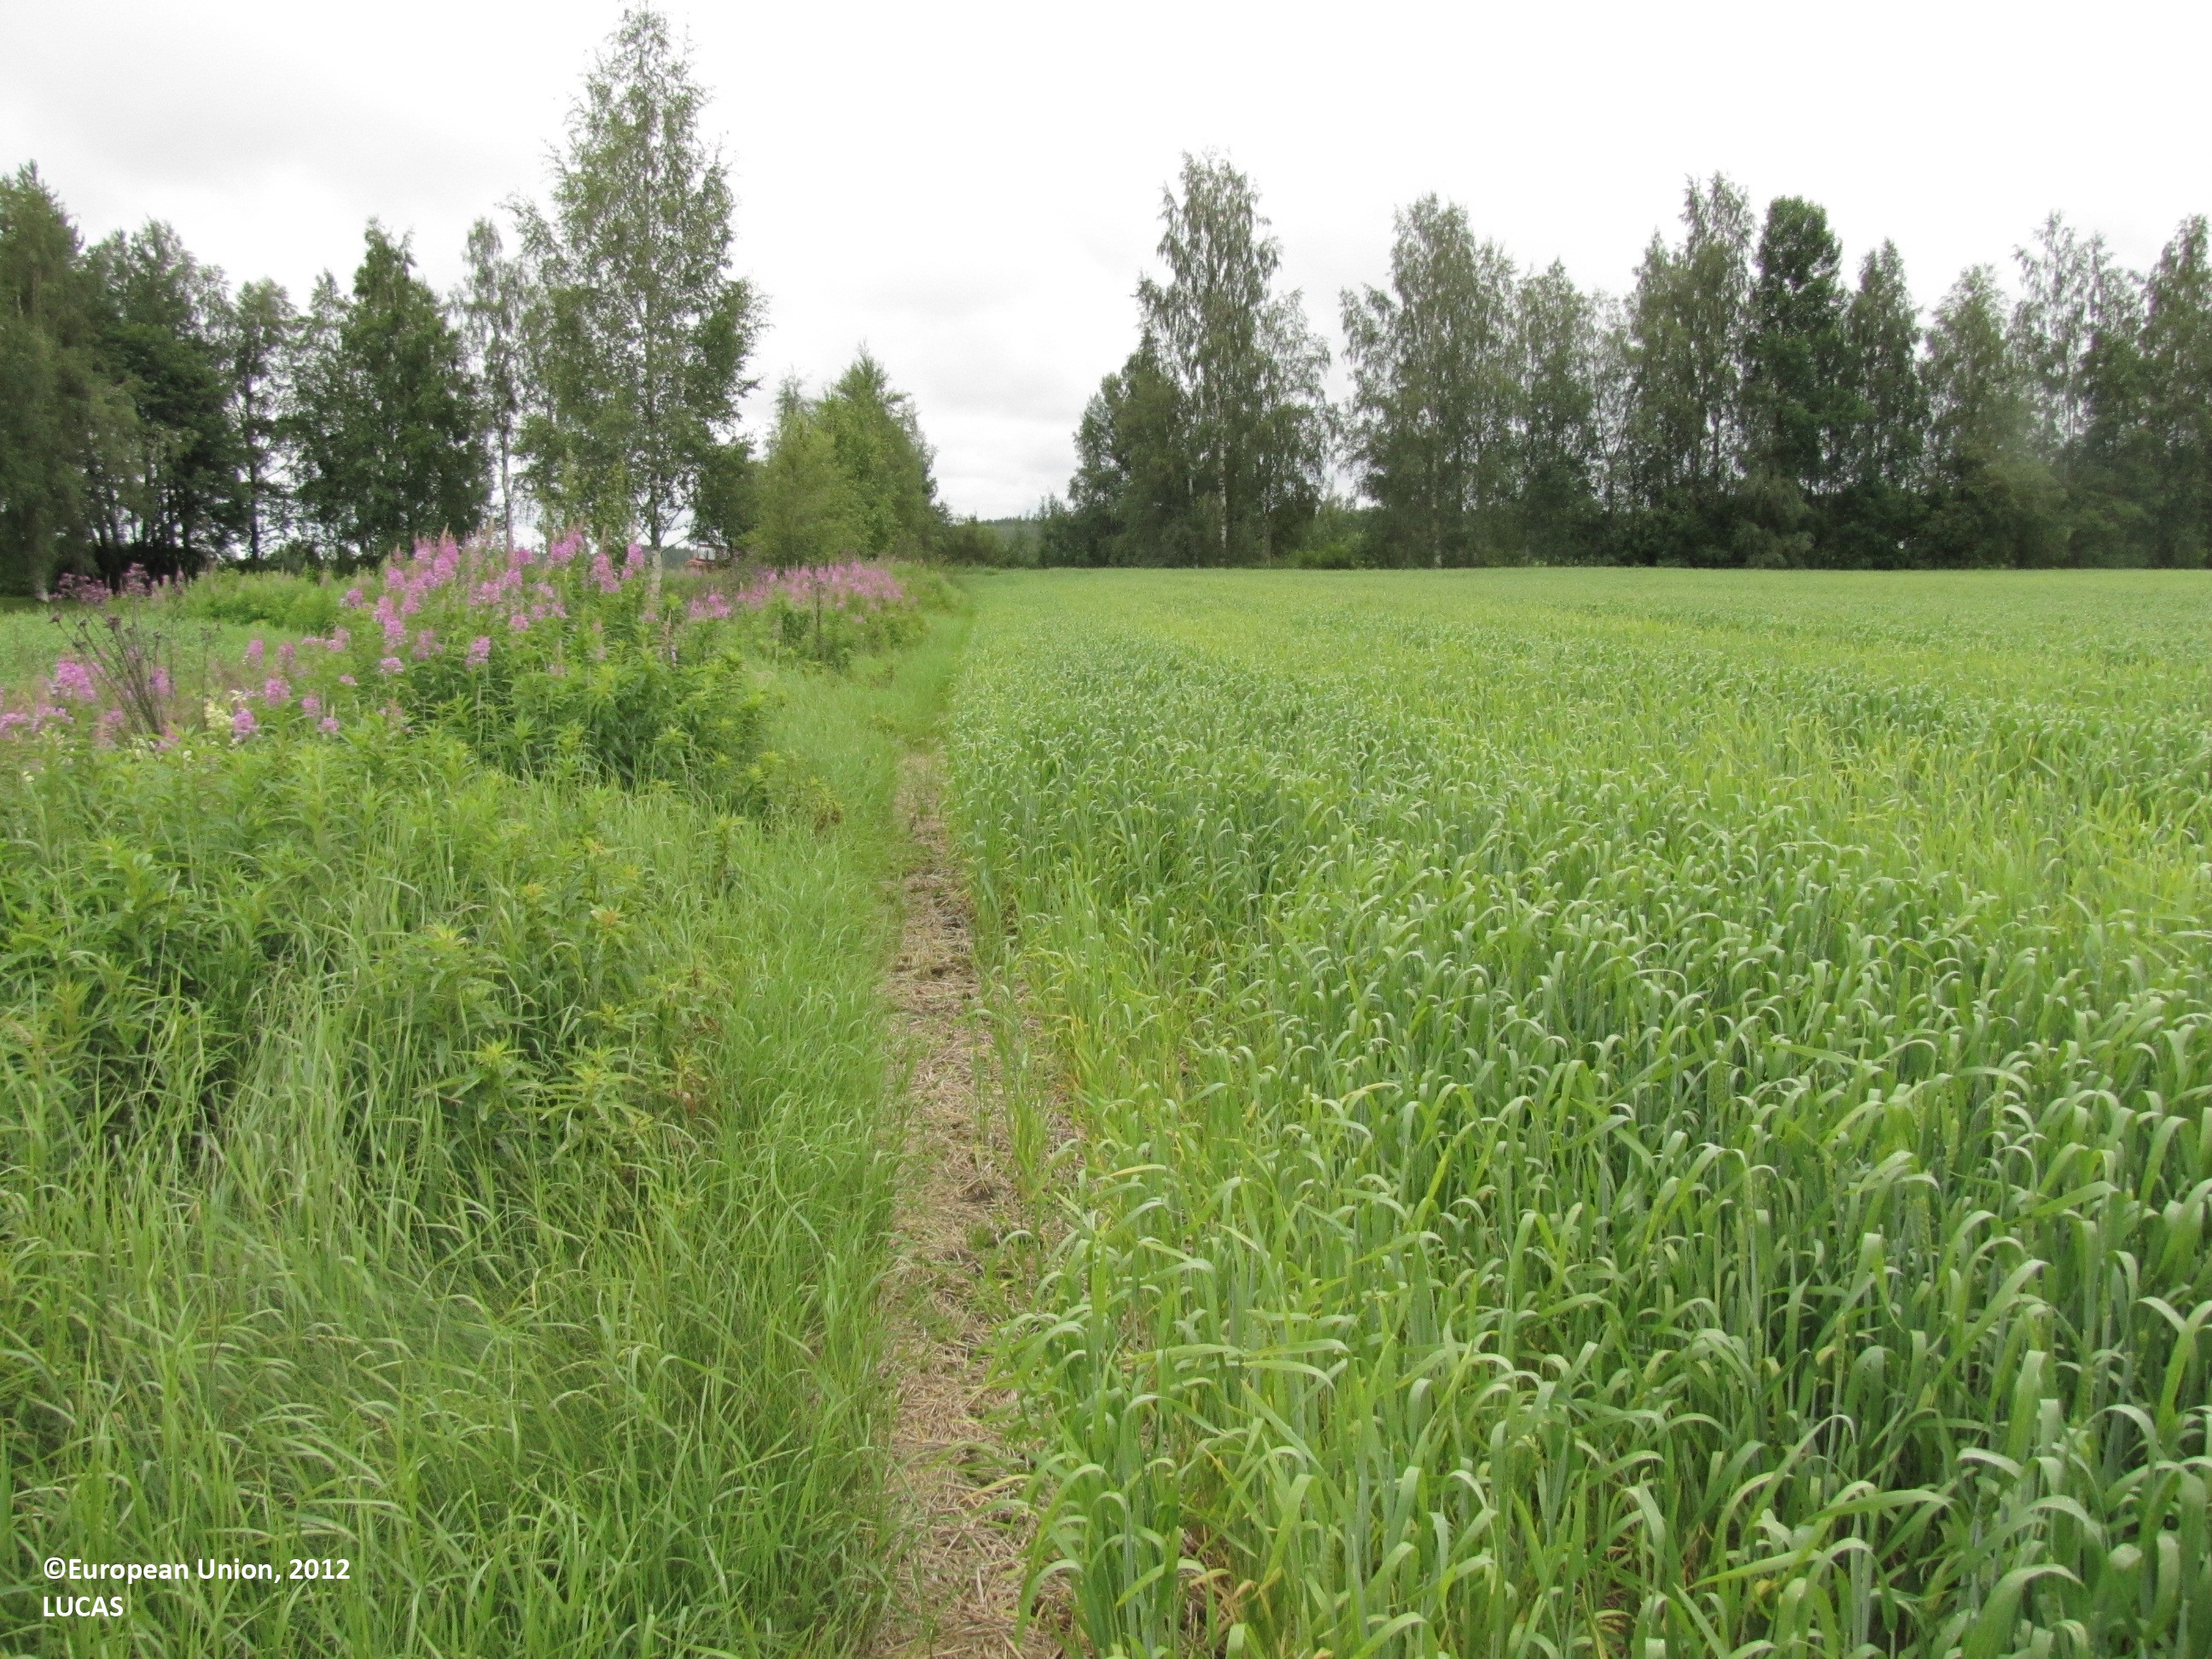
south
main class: Cropland
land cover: Common wheat
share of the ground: > 75 %
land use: Agriculture (excluding fallow land and kitchen gardens)
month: July
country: FI
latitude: 62.4851
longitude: 23.0049
